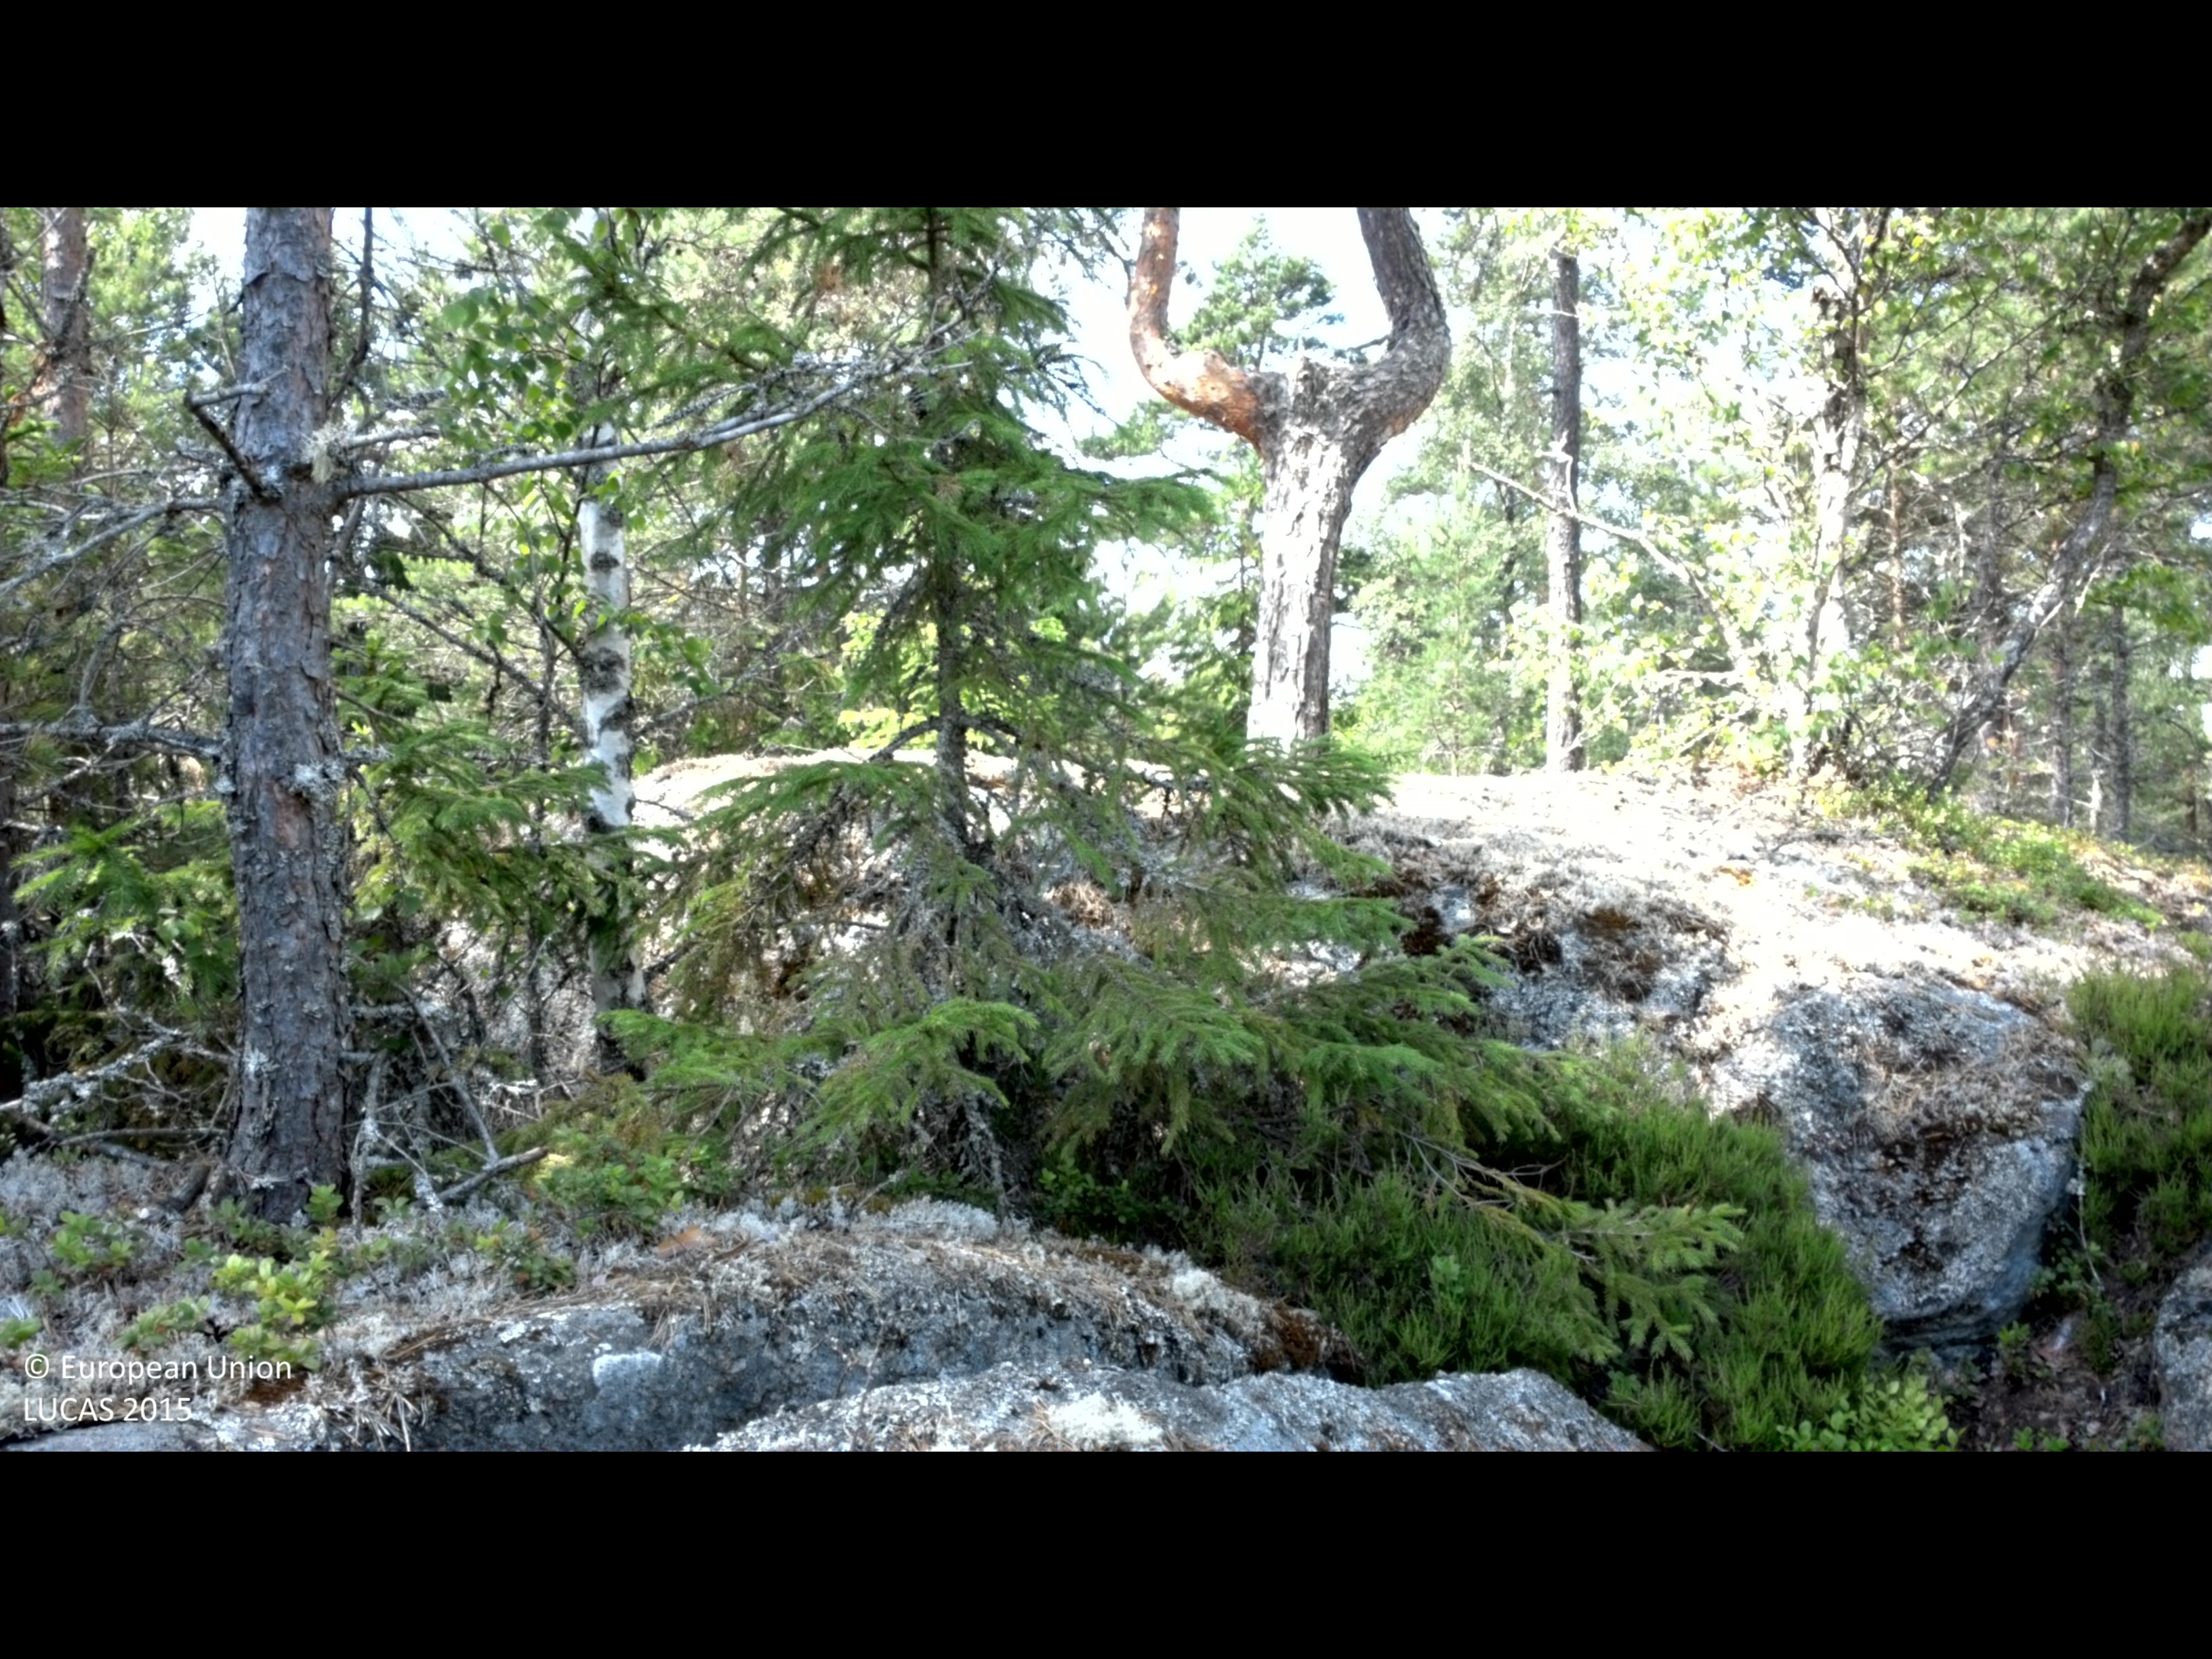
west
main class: Woodland
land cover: Pine dominated mixed woodland
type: boreal forest
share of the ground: 50 - 75 %
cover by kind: coniferous forest trees 45 %, shrubs 20 %, lichens and mosses 20 %, broadleaved forest trees 15 %
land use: Forestry
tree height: > 5 m
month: June
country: SE
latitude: 58.2071
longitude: 16.1054
